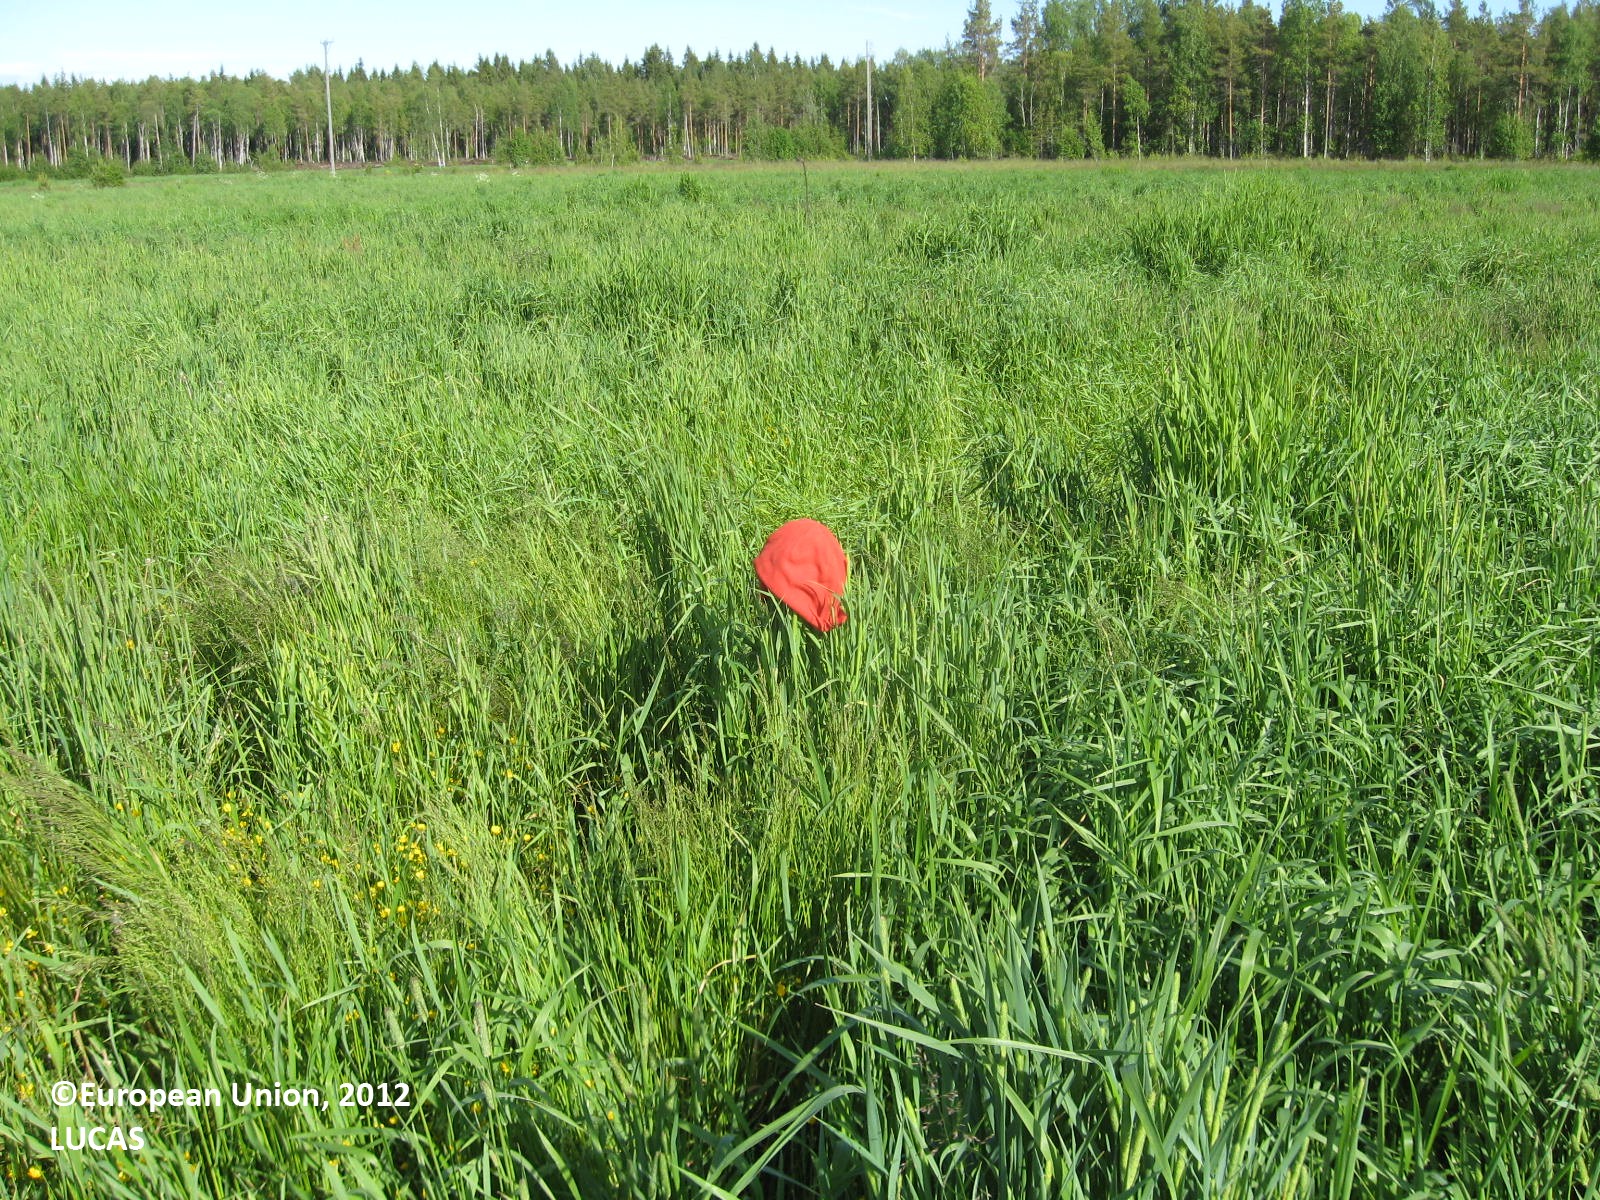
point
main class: Cropland
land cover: Temporary grasslands
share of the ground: > 75 %
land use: Agriculture (excluding fallow land and kitchen gardens)
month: June
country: FI
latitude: 62.6484
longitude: 21.6915
